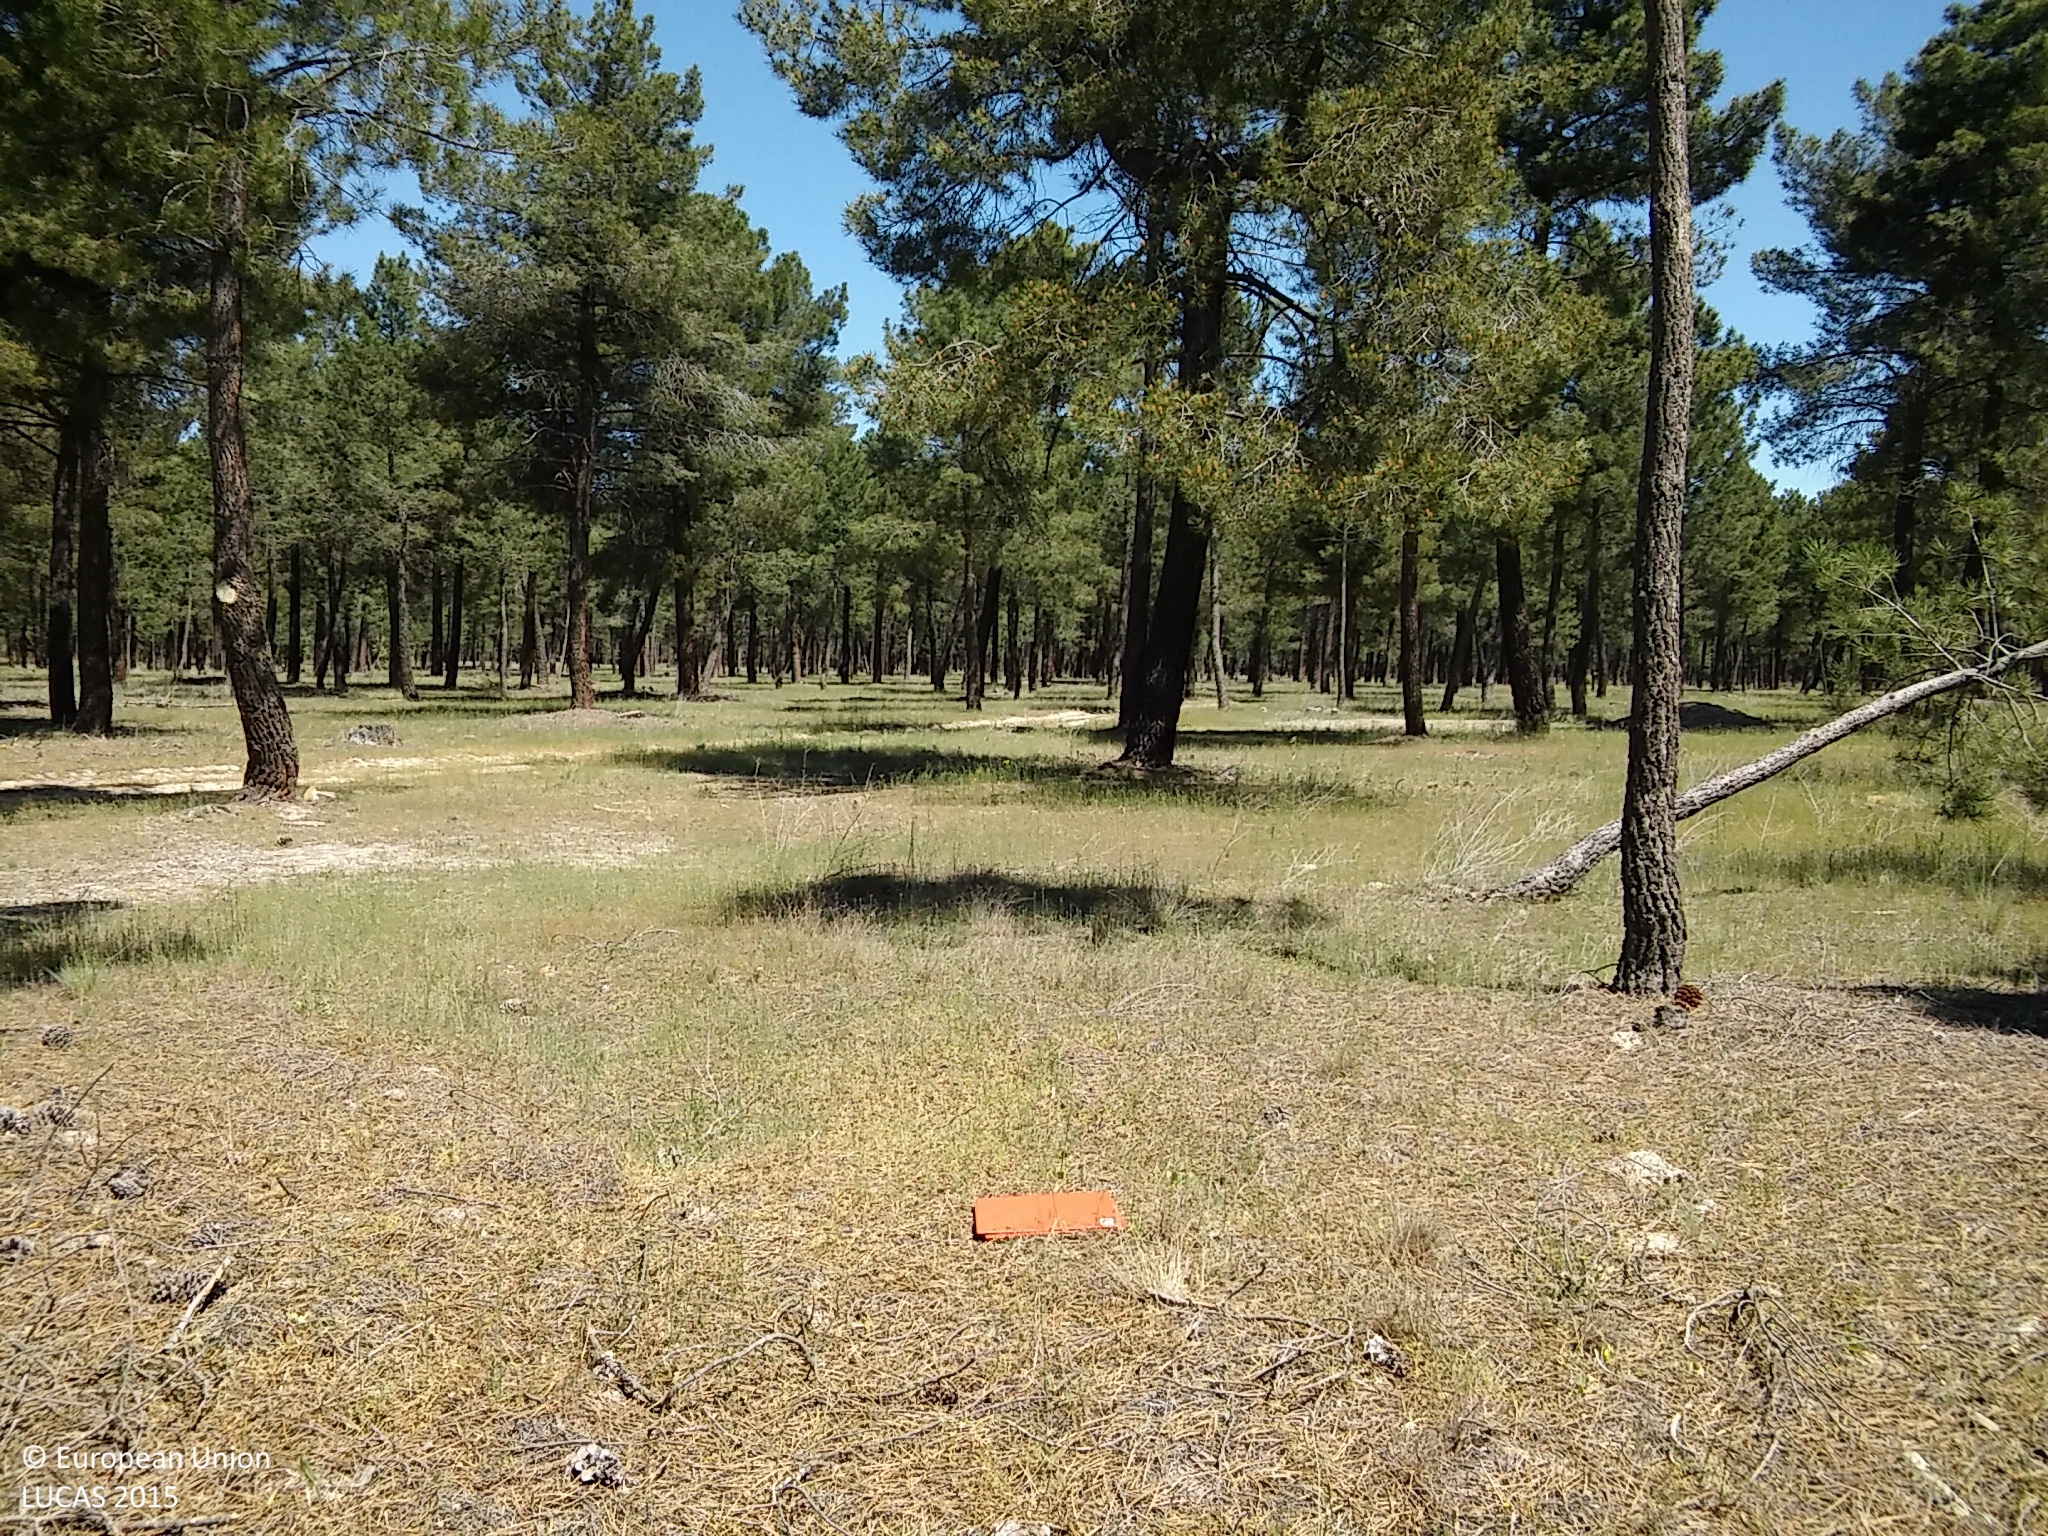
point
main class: Woodland
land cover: Pine dominated coniferous woodland
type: coniferous forest of the mediterranean region
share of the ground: 10 - 25 %
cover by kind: unconsolidated bare surface 50 %, herbaceous plants 30 %, coniferous forest trees 20 %
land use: Forestry
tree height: > 5 m
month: May
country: ES
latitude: 41.2125
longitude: -4.0427
